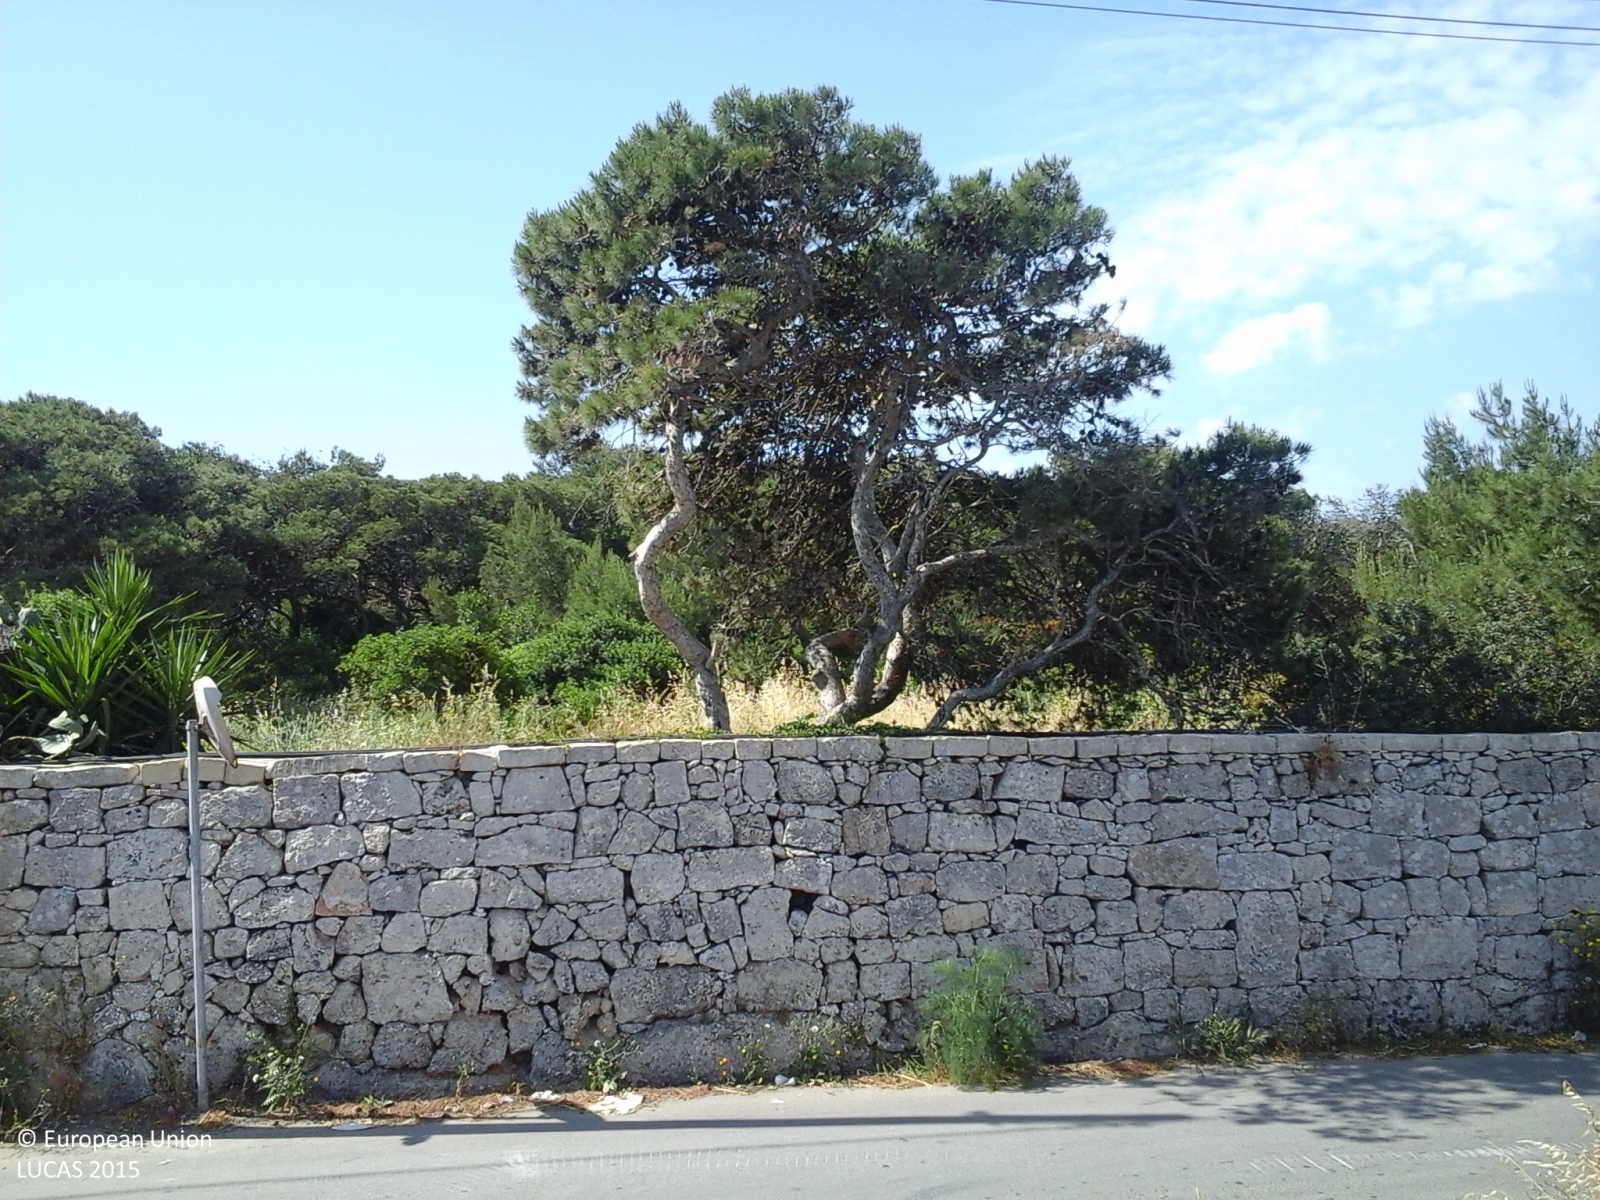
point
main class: Woodland
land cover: Pine dominated coniferous woodland
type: coniferous forest of the mediterranean region
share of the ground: > 75 %
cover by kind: coniferous forest trees 80 %, herbaceous plants 20 %
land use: Residential
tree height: > 5 m
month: May
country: MT
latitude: 35.8623
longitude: 14.3999
